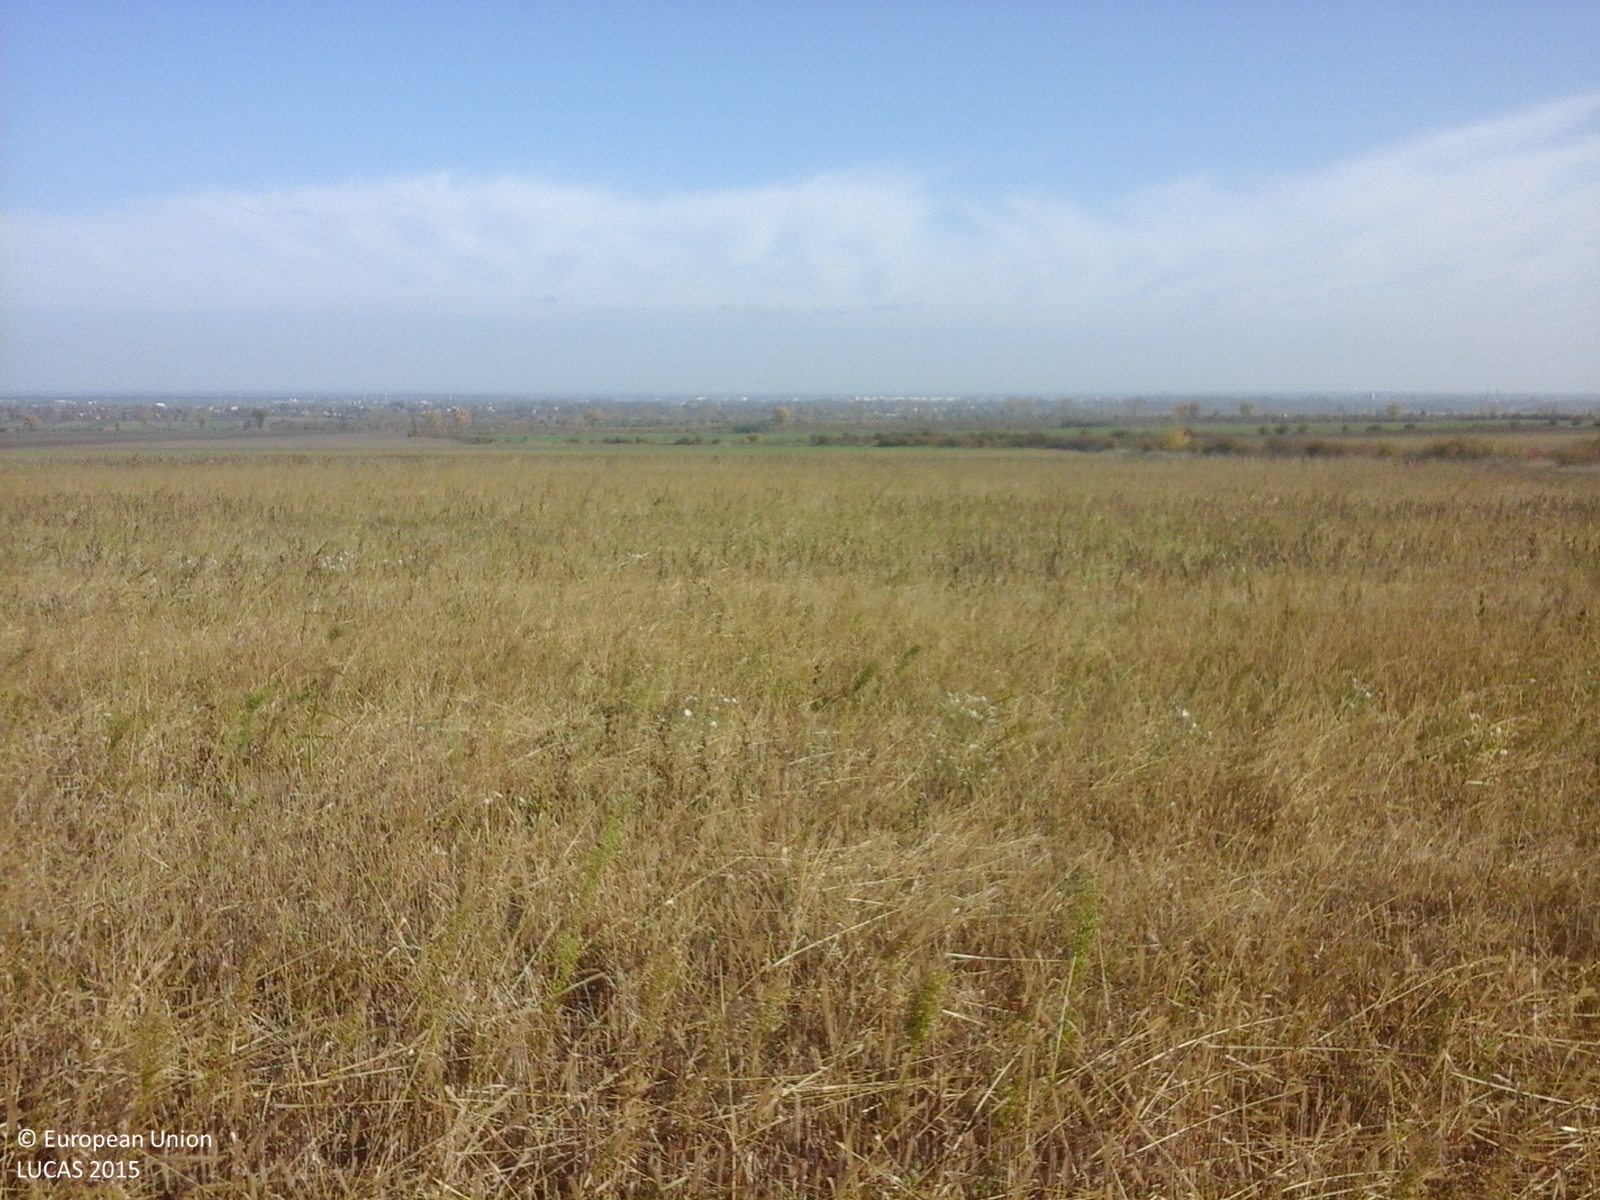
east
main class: Grassland
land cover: Spontaneously vegetated surfaces
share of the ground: > 75 %
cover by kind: herbaceous plants 100 %
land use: Fallow land
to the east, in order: Spontaneously vegetated surfaces; Maize; Other bare soil; Grassland without tree/shrub cover
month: October
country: RO
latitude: 45.6996
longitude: 27.0834
